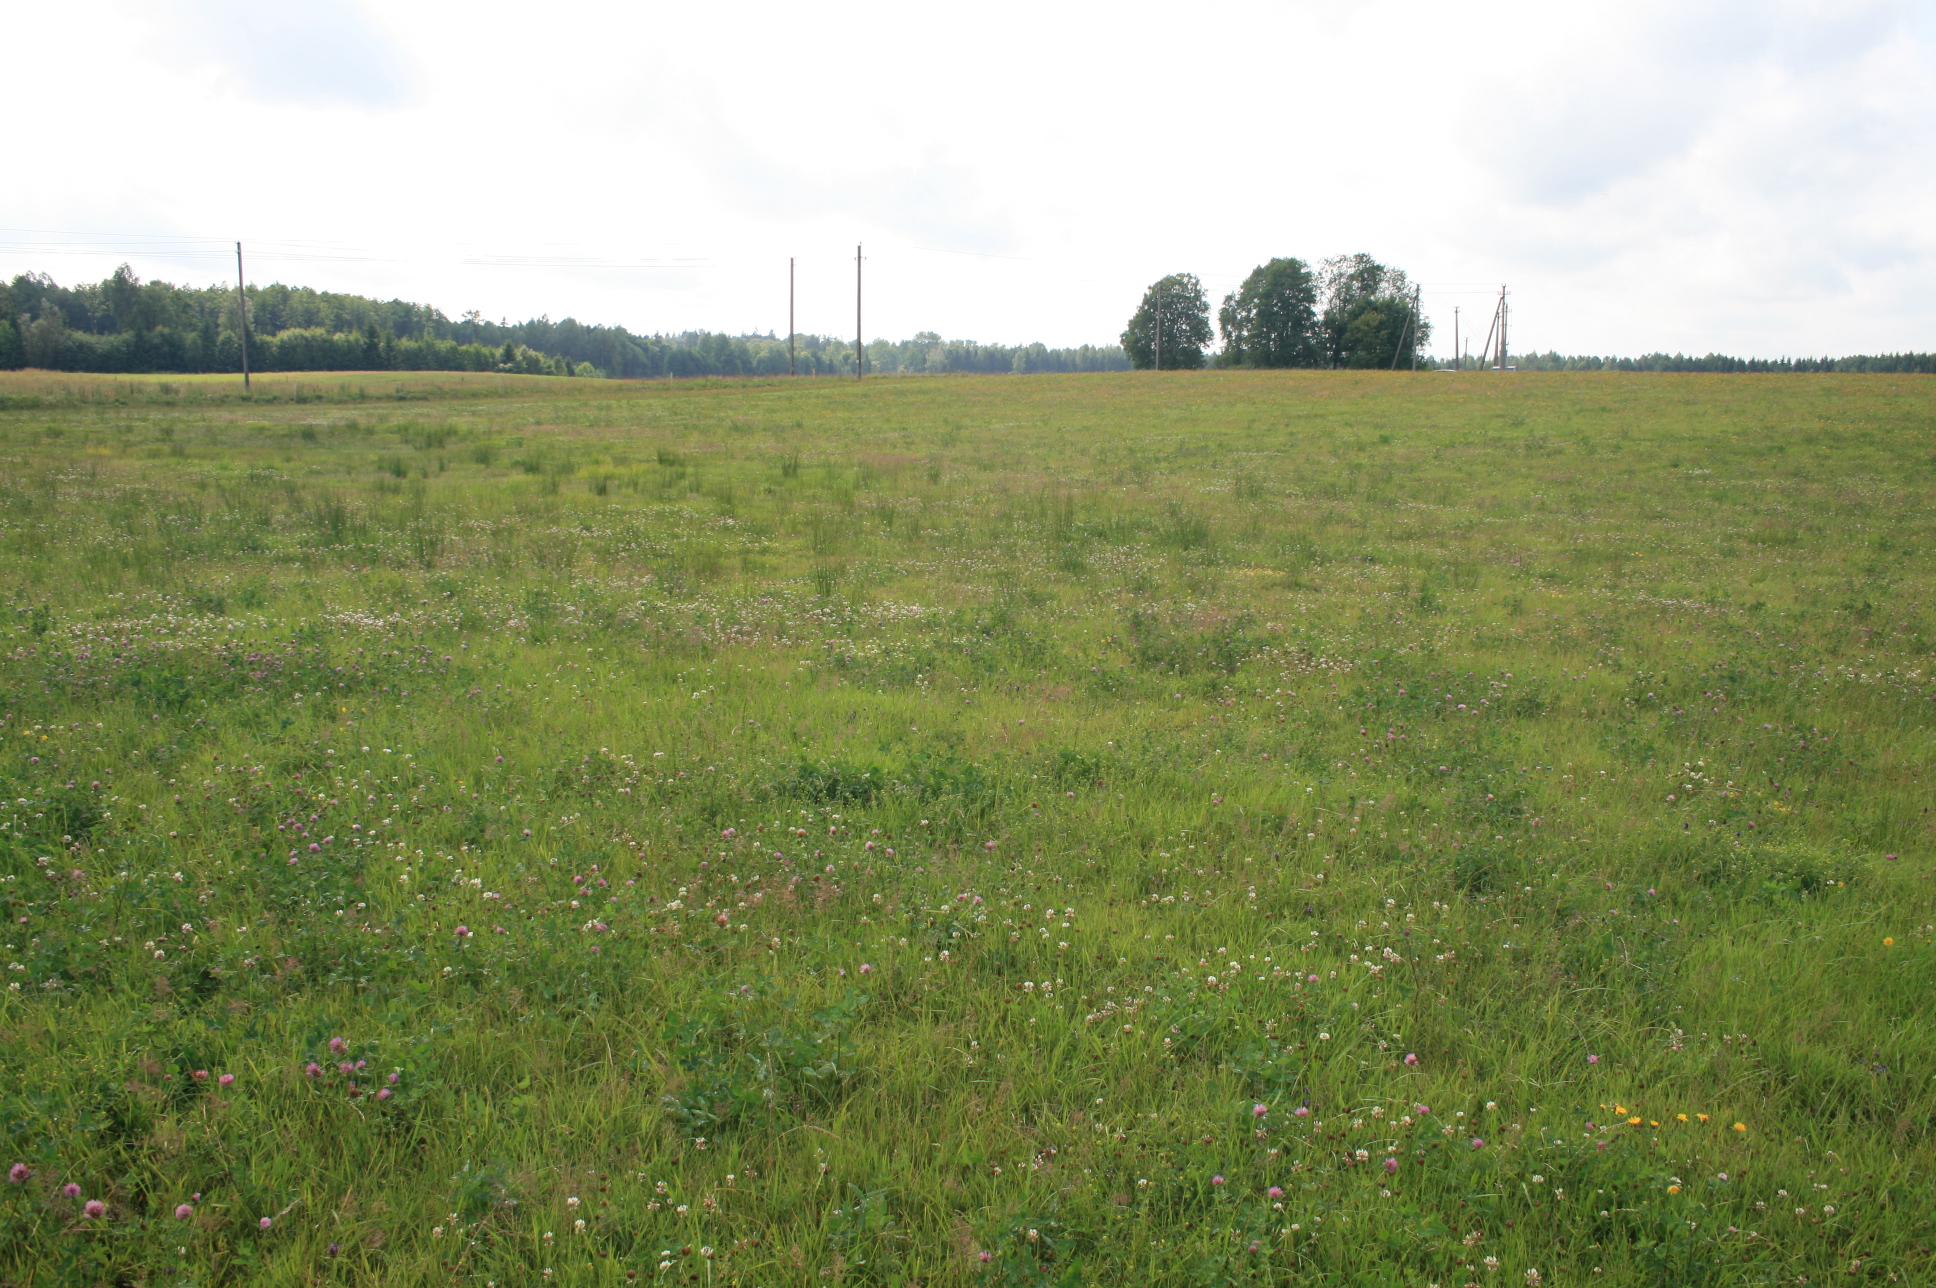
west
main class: Grassland
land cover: Grassland without tree/shrub cover
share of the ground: > 75 %
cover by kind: herbaceous plants 100 %
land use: Agriculture (excluding fallow land and kitchen gardens)
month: July
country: LT
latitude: 55.5299
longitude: 21.8214
